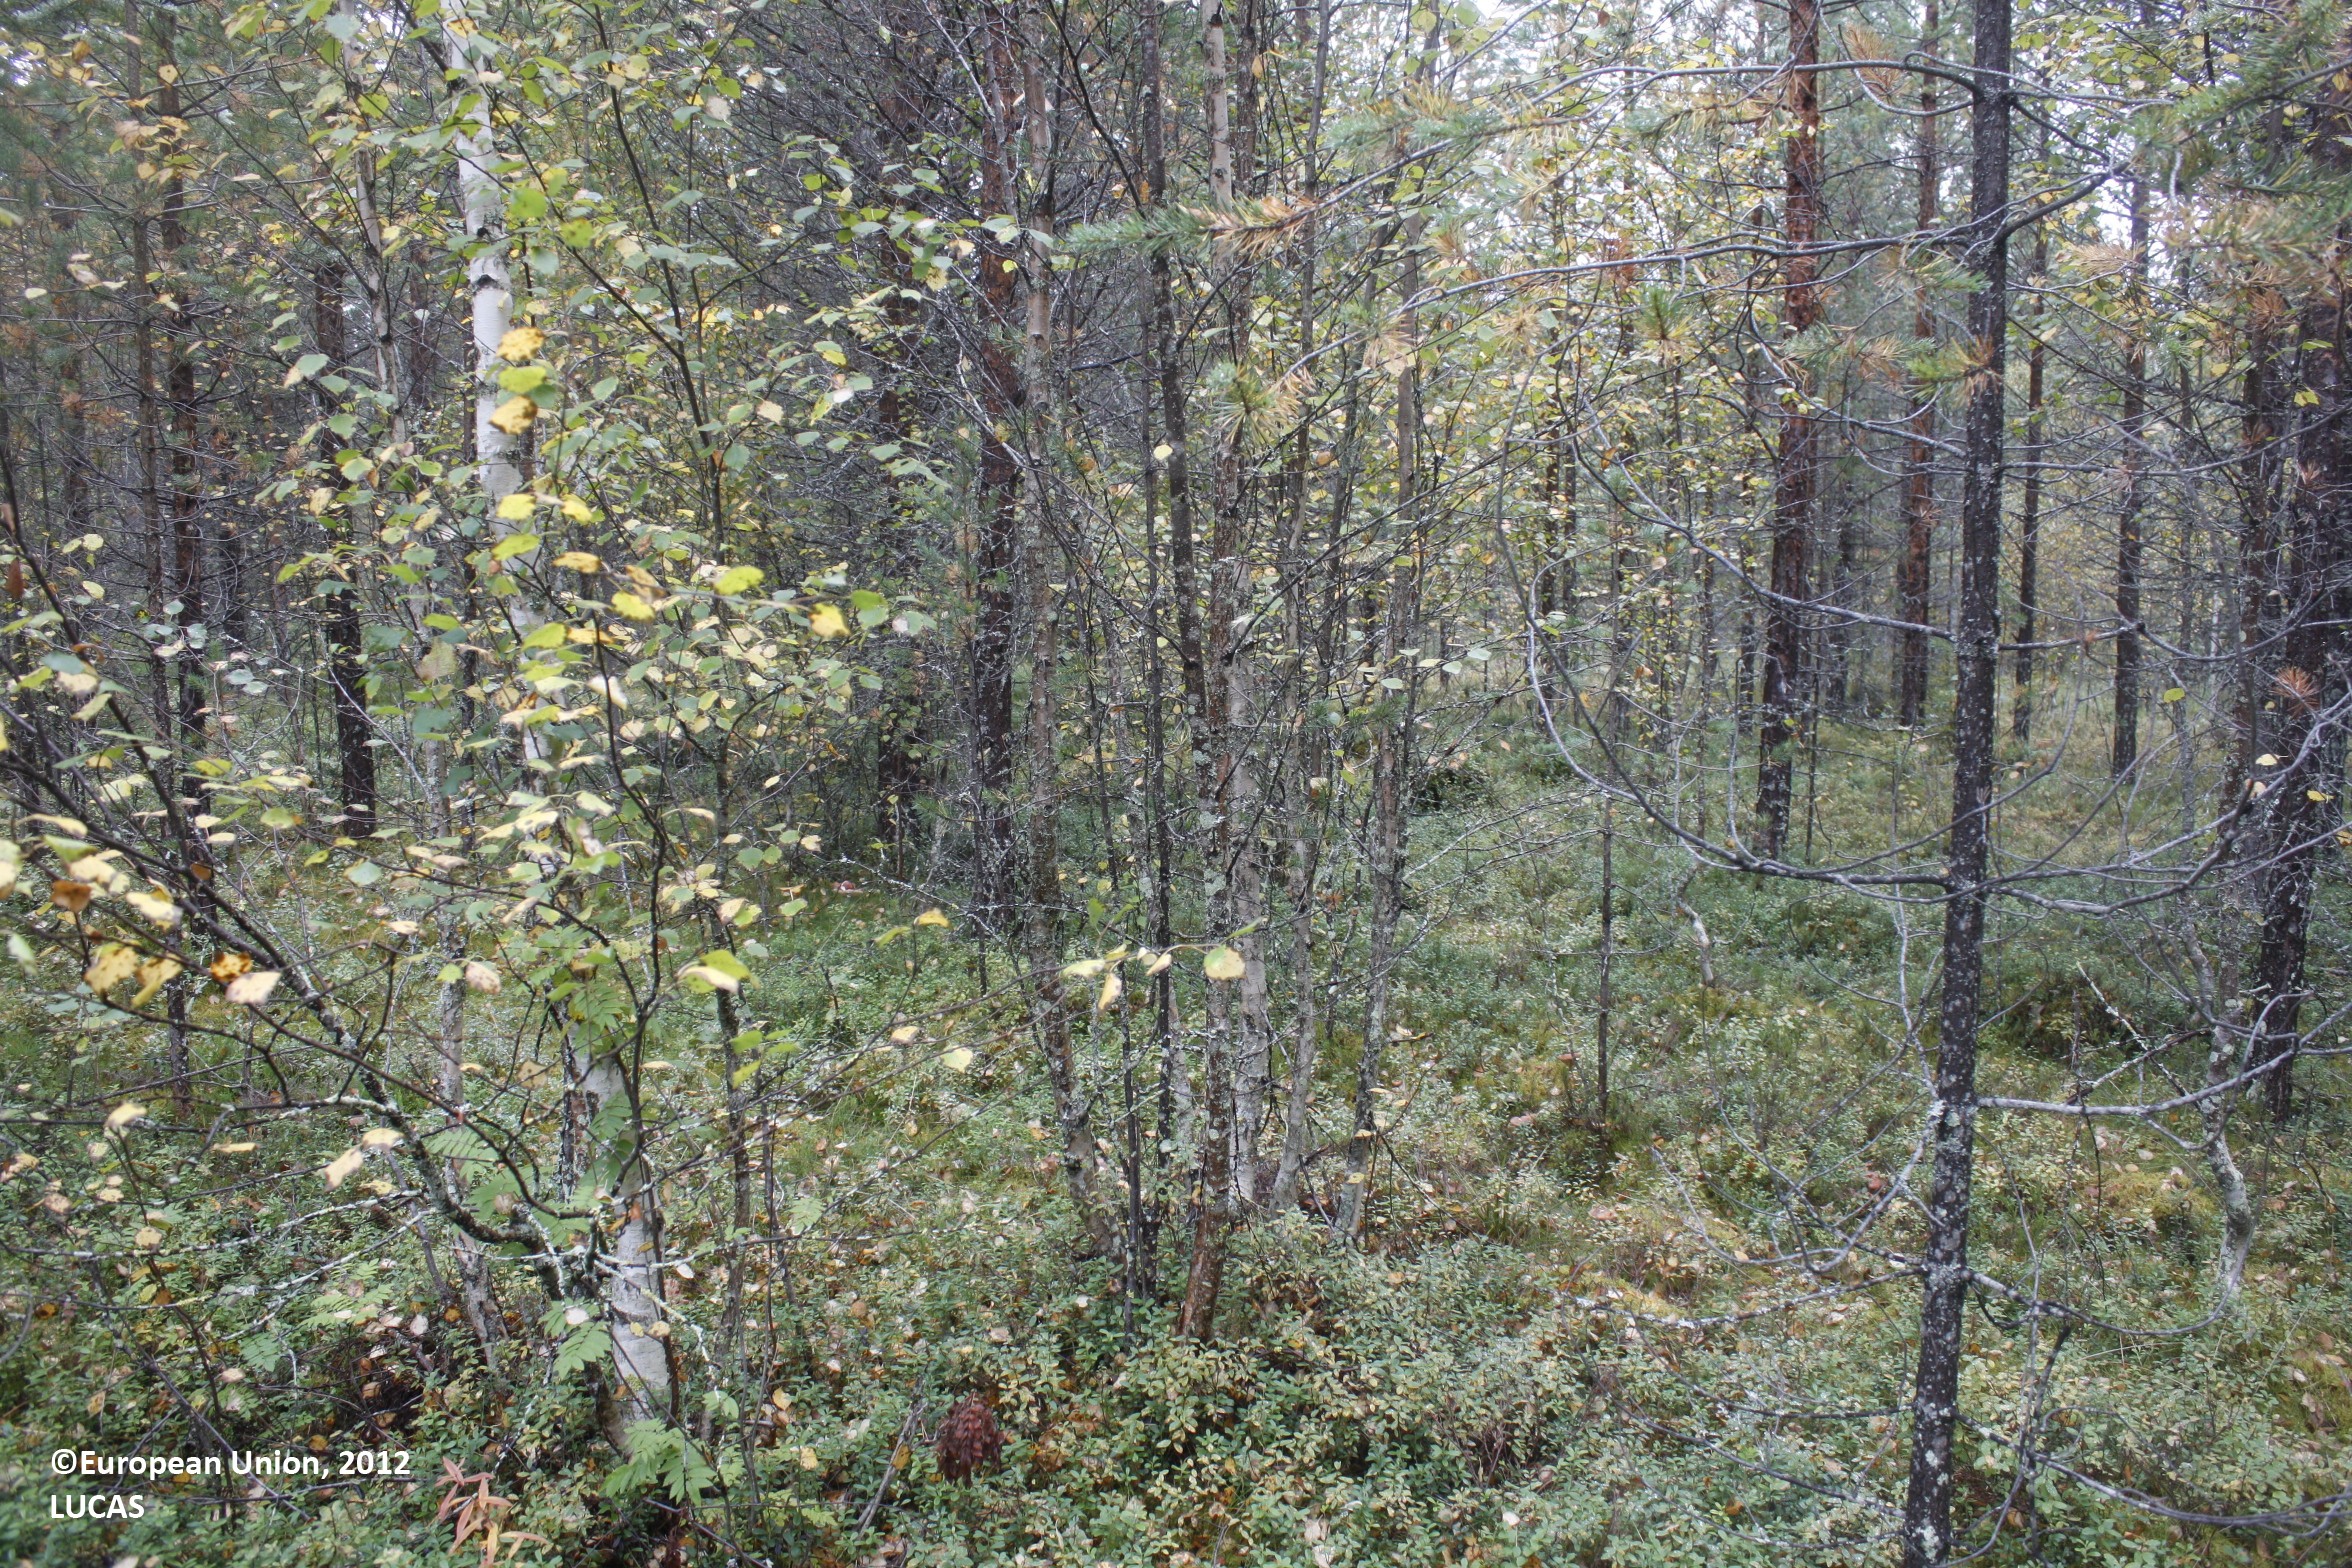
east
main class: Woodland
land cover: Pine dominated mixed woodland
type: boreal forest
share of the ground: 50 - 75 %
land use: Forestry
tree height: > 5 m
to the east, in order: Pine dominated mixed woodland
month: September
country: FI
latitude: 65.1747
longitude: 26.6969
